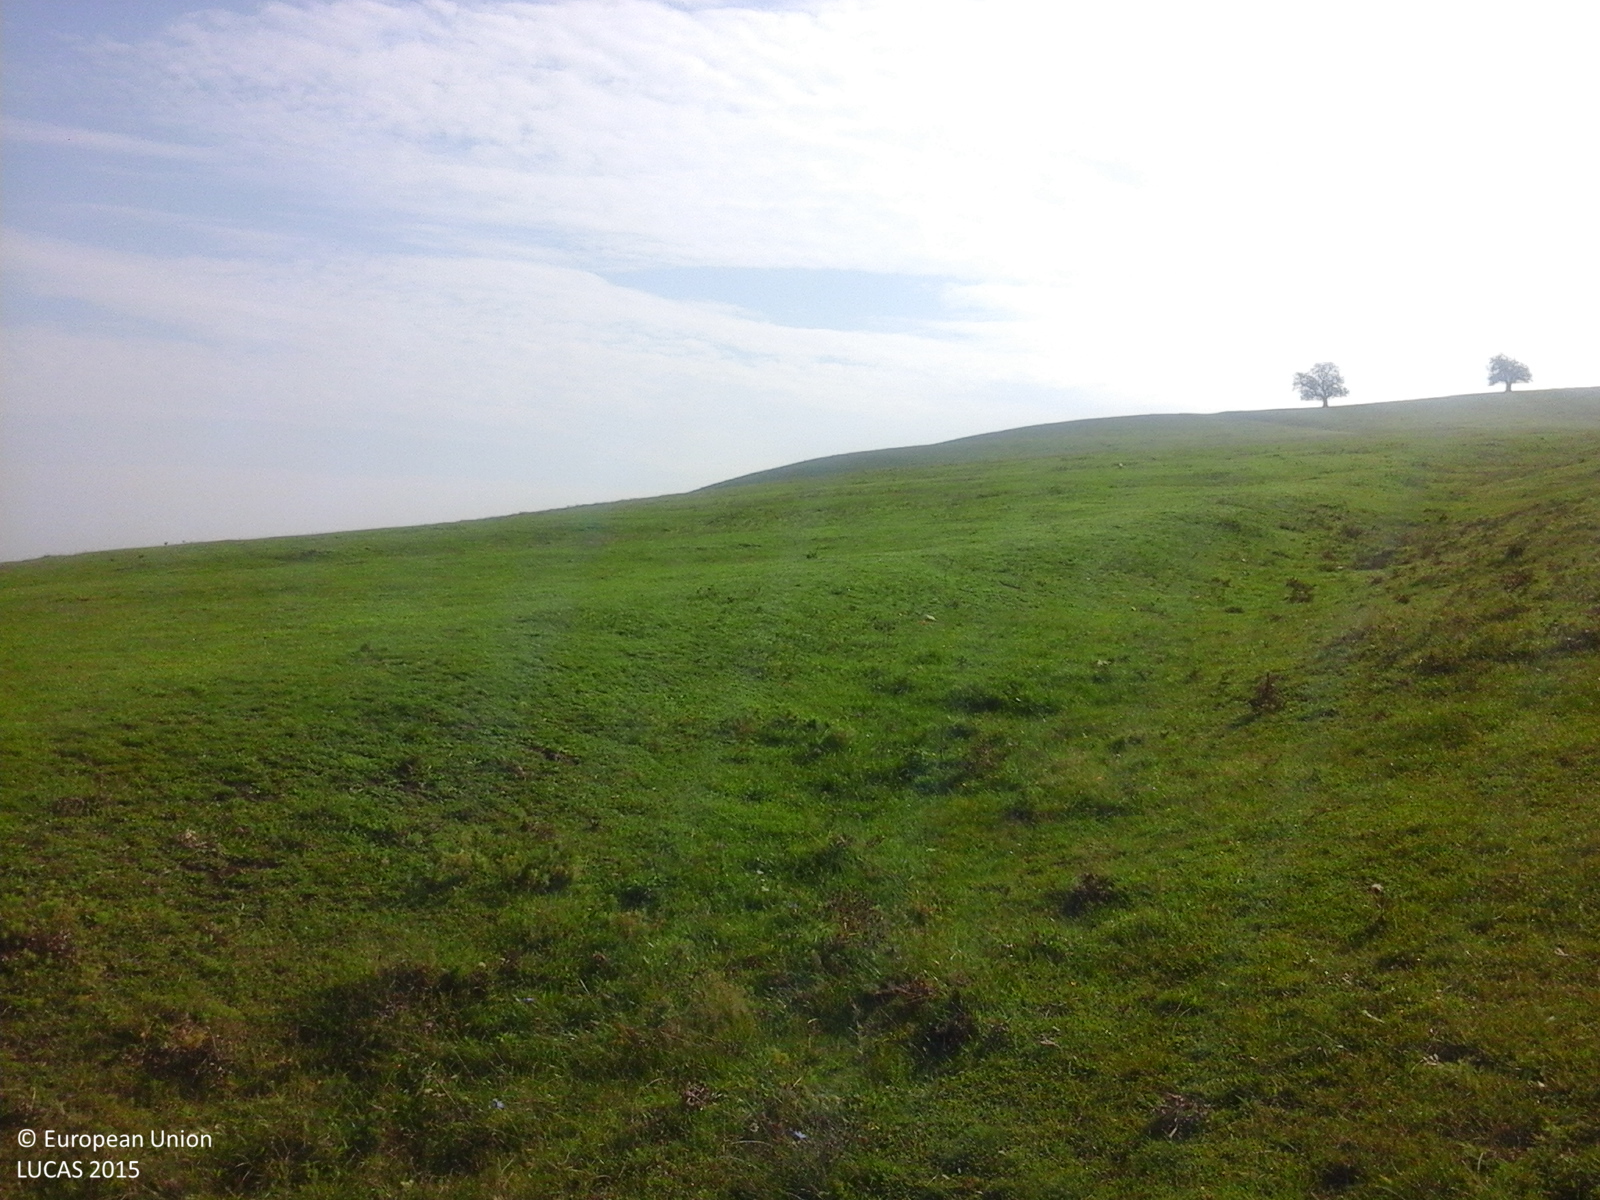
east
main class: Grassland
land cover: Grassland without tree/shrub cover
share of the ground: > 75 %
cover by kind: herbaceous plants 100 %
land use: Agriculture (excluding fallow land and kitchen gardens)
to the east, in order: Grassland without tree/shrub cover
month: October
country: RO
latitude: 46.1501
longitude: 23.6237
